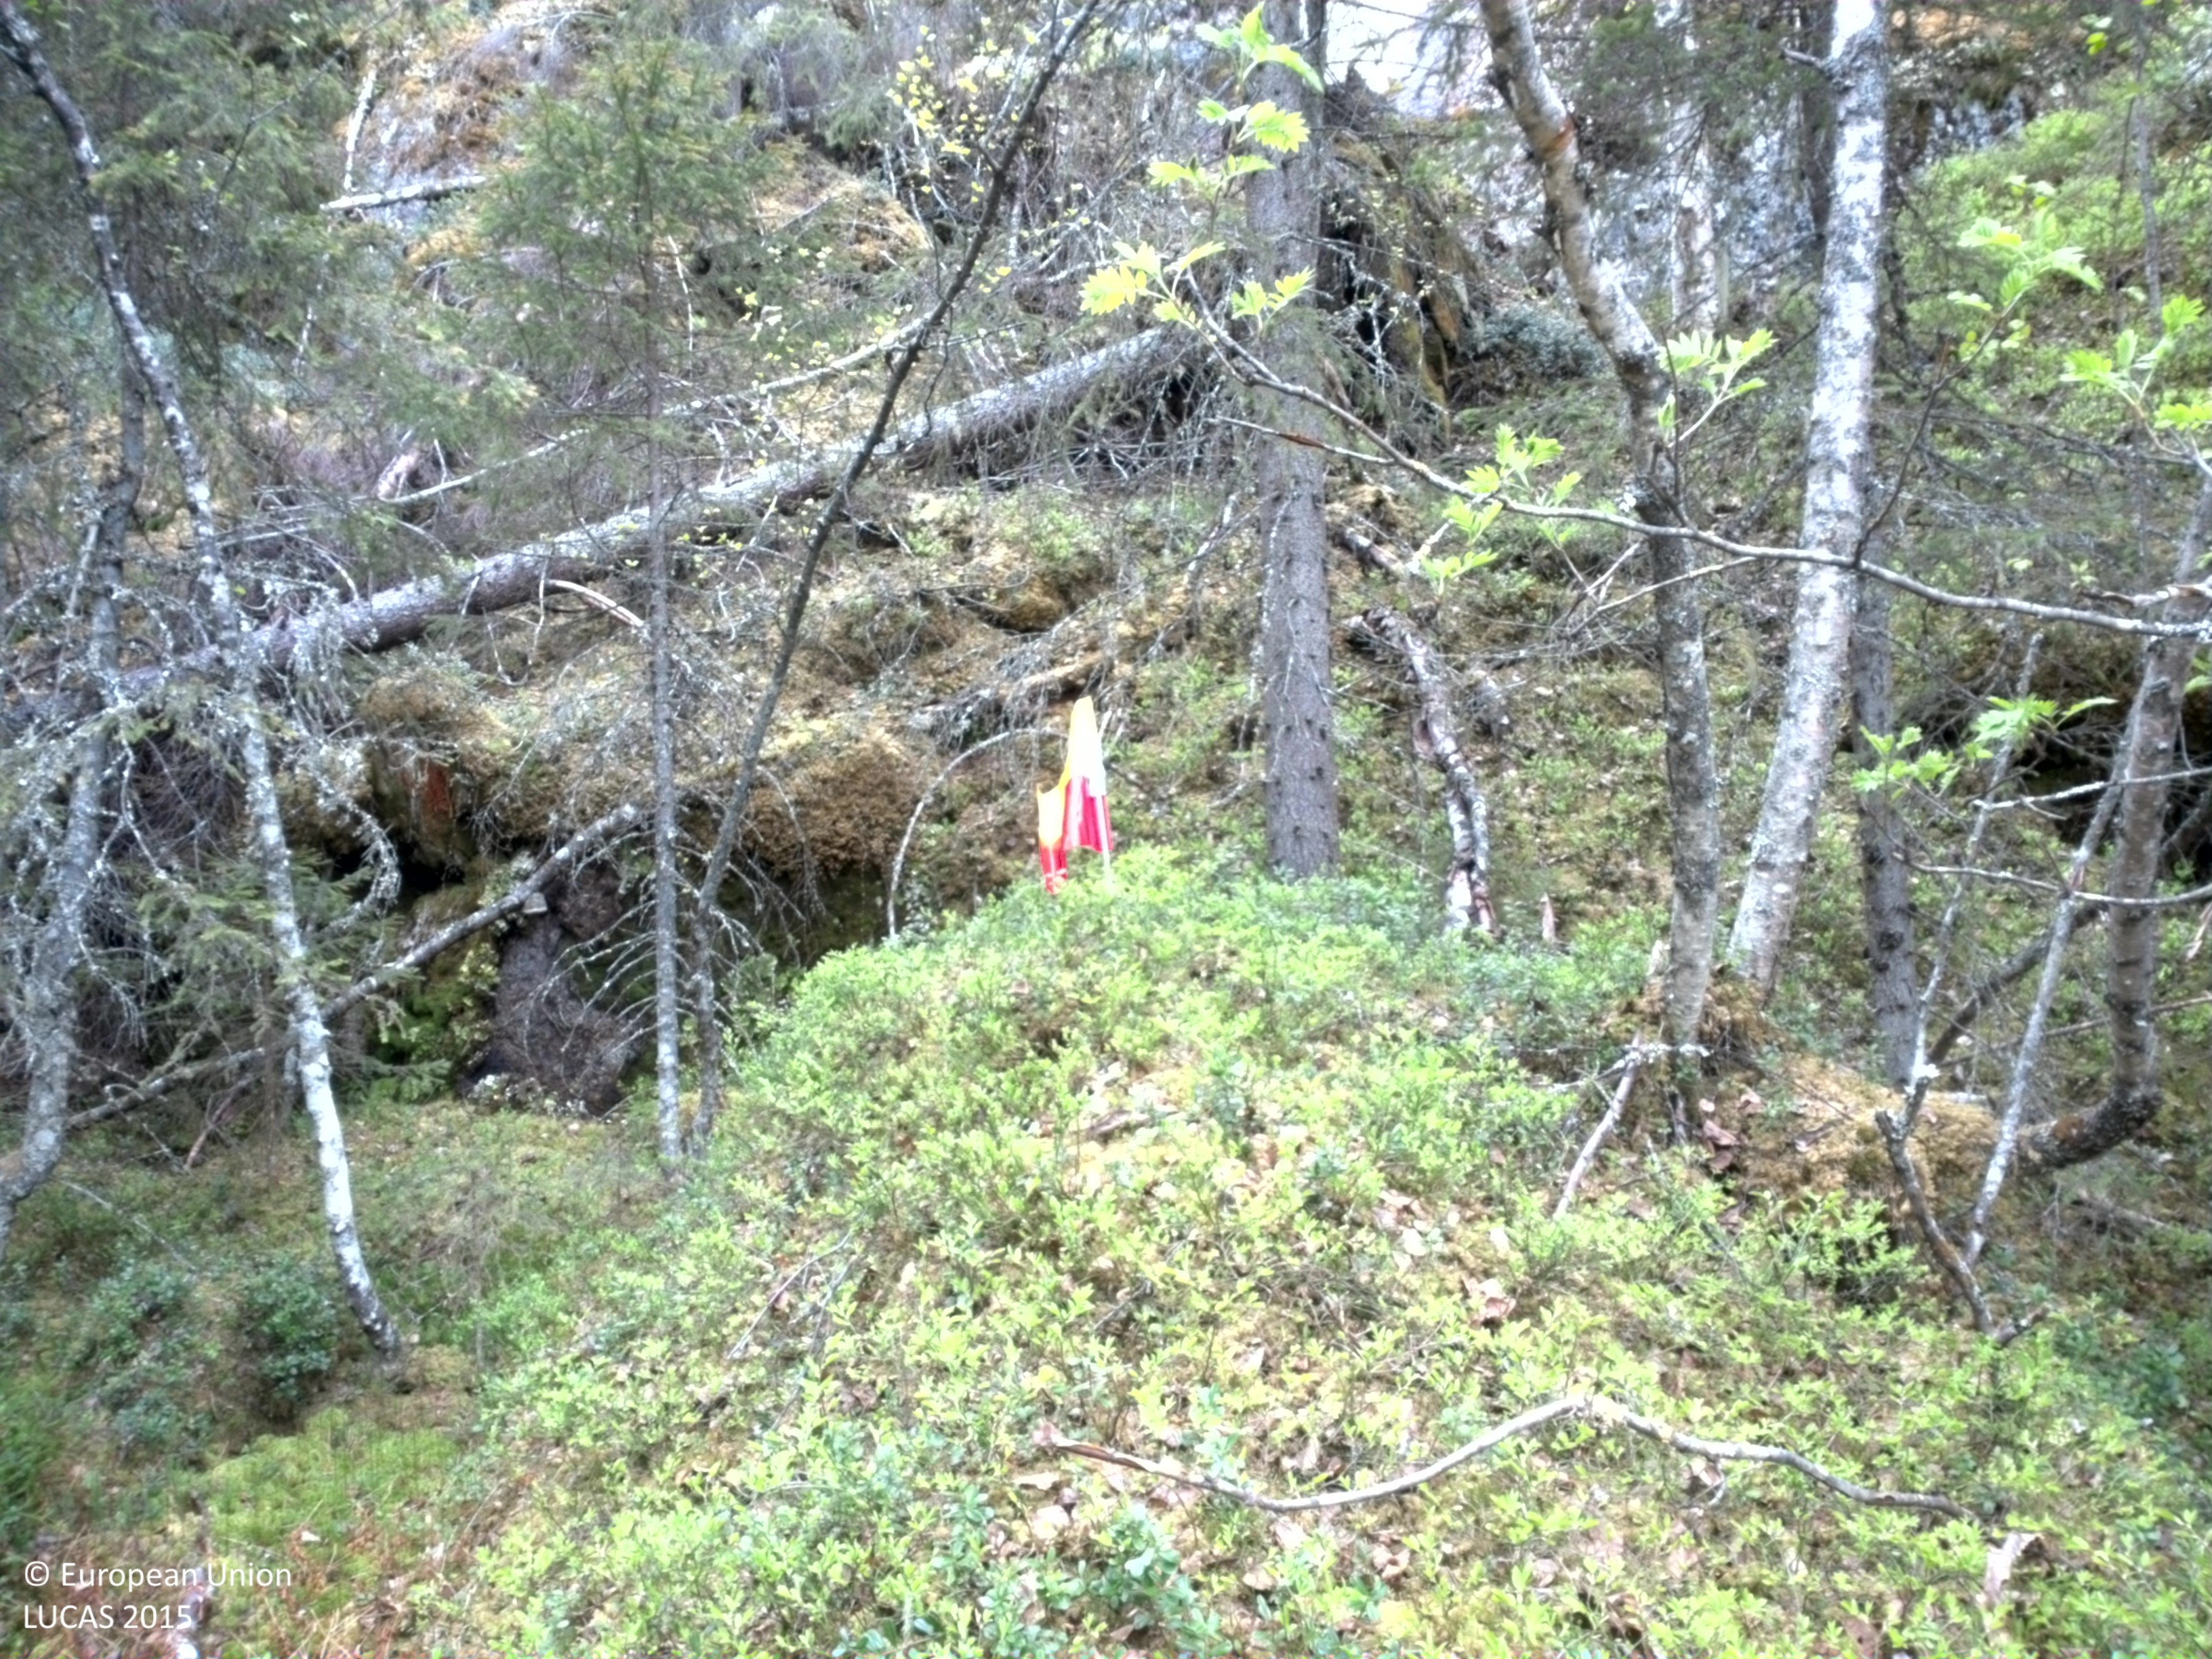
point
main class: Woodland
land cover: Spruce dominated mixed woodland
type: boreal forest
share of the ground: 50 - 75 %
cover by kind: coniferous forest trees 45 %, herbaceous plants 20 %, broadleaved forest trees 15 %, lichens and mosses 15 %, shrubs 5 %
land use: Forestry
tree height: > 5 m
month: June
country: SE
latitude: 64.2310
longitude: 18.0305
